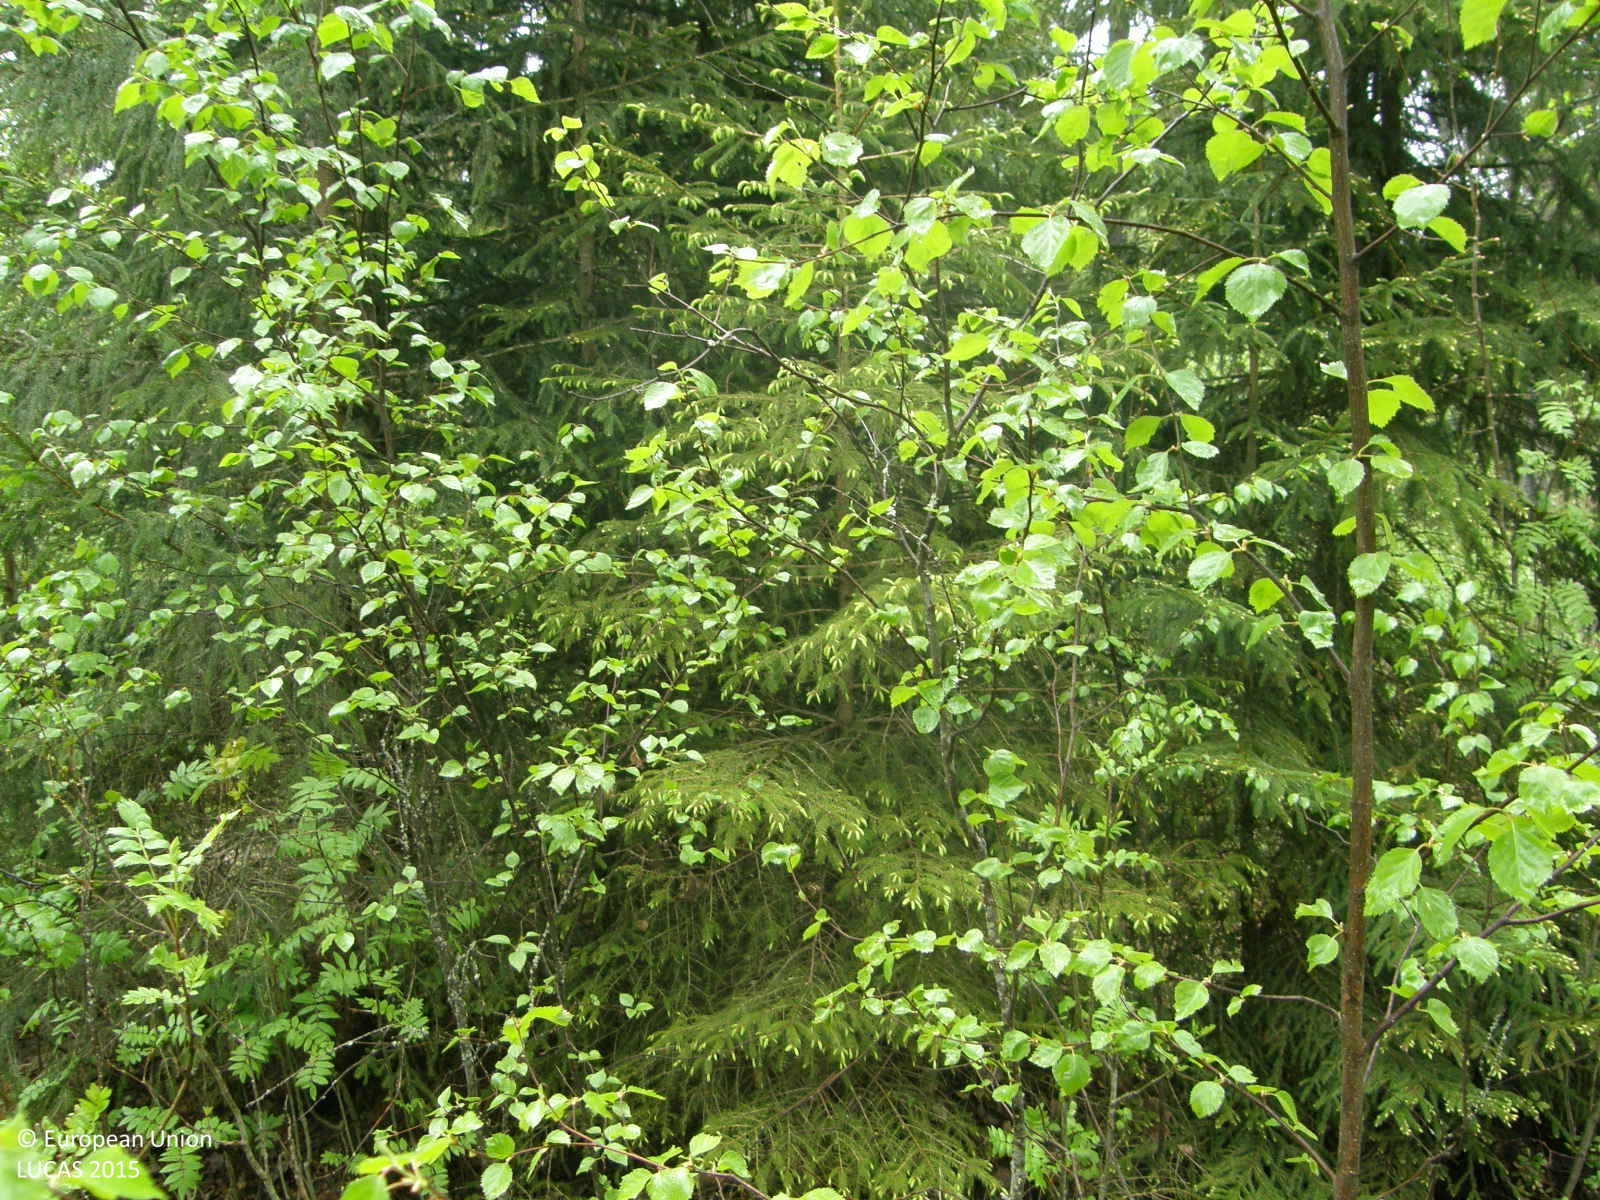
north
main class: Woodland
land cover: Other mixed woodland
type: boreal forest
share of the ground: > 75 %
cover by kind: coniferous forest trees 45 %, broadleaved forest trees 35 %, shrubs 20 %
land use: Forestry
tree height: > 5 m
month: June
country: FI
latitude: 61.9598
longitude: 21.6234
